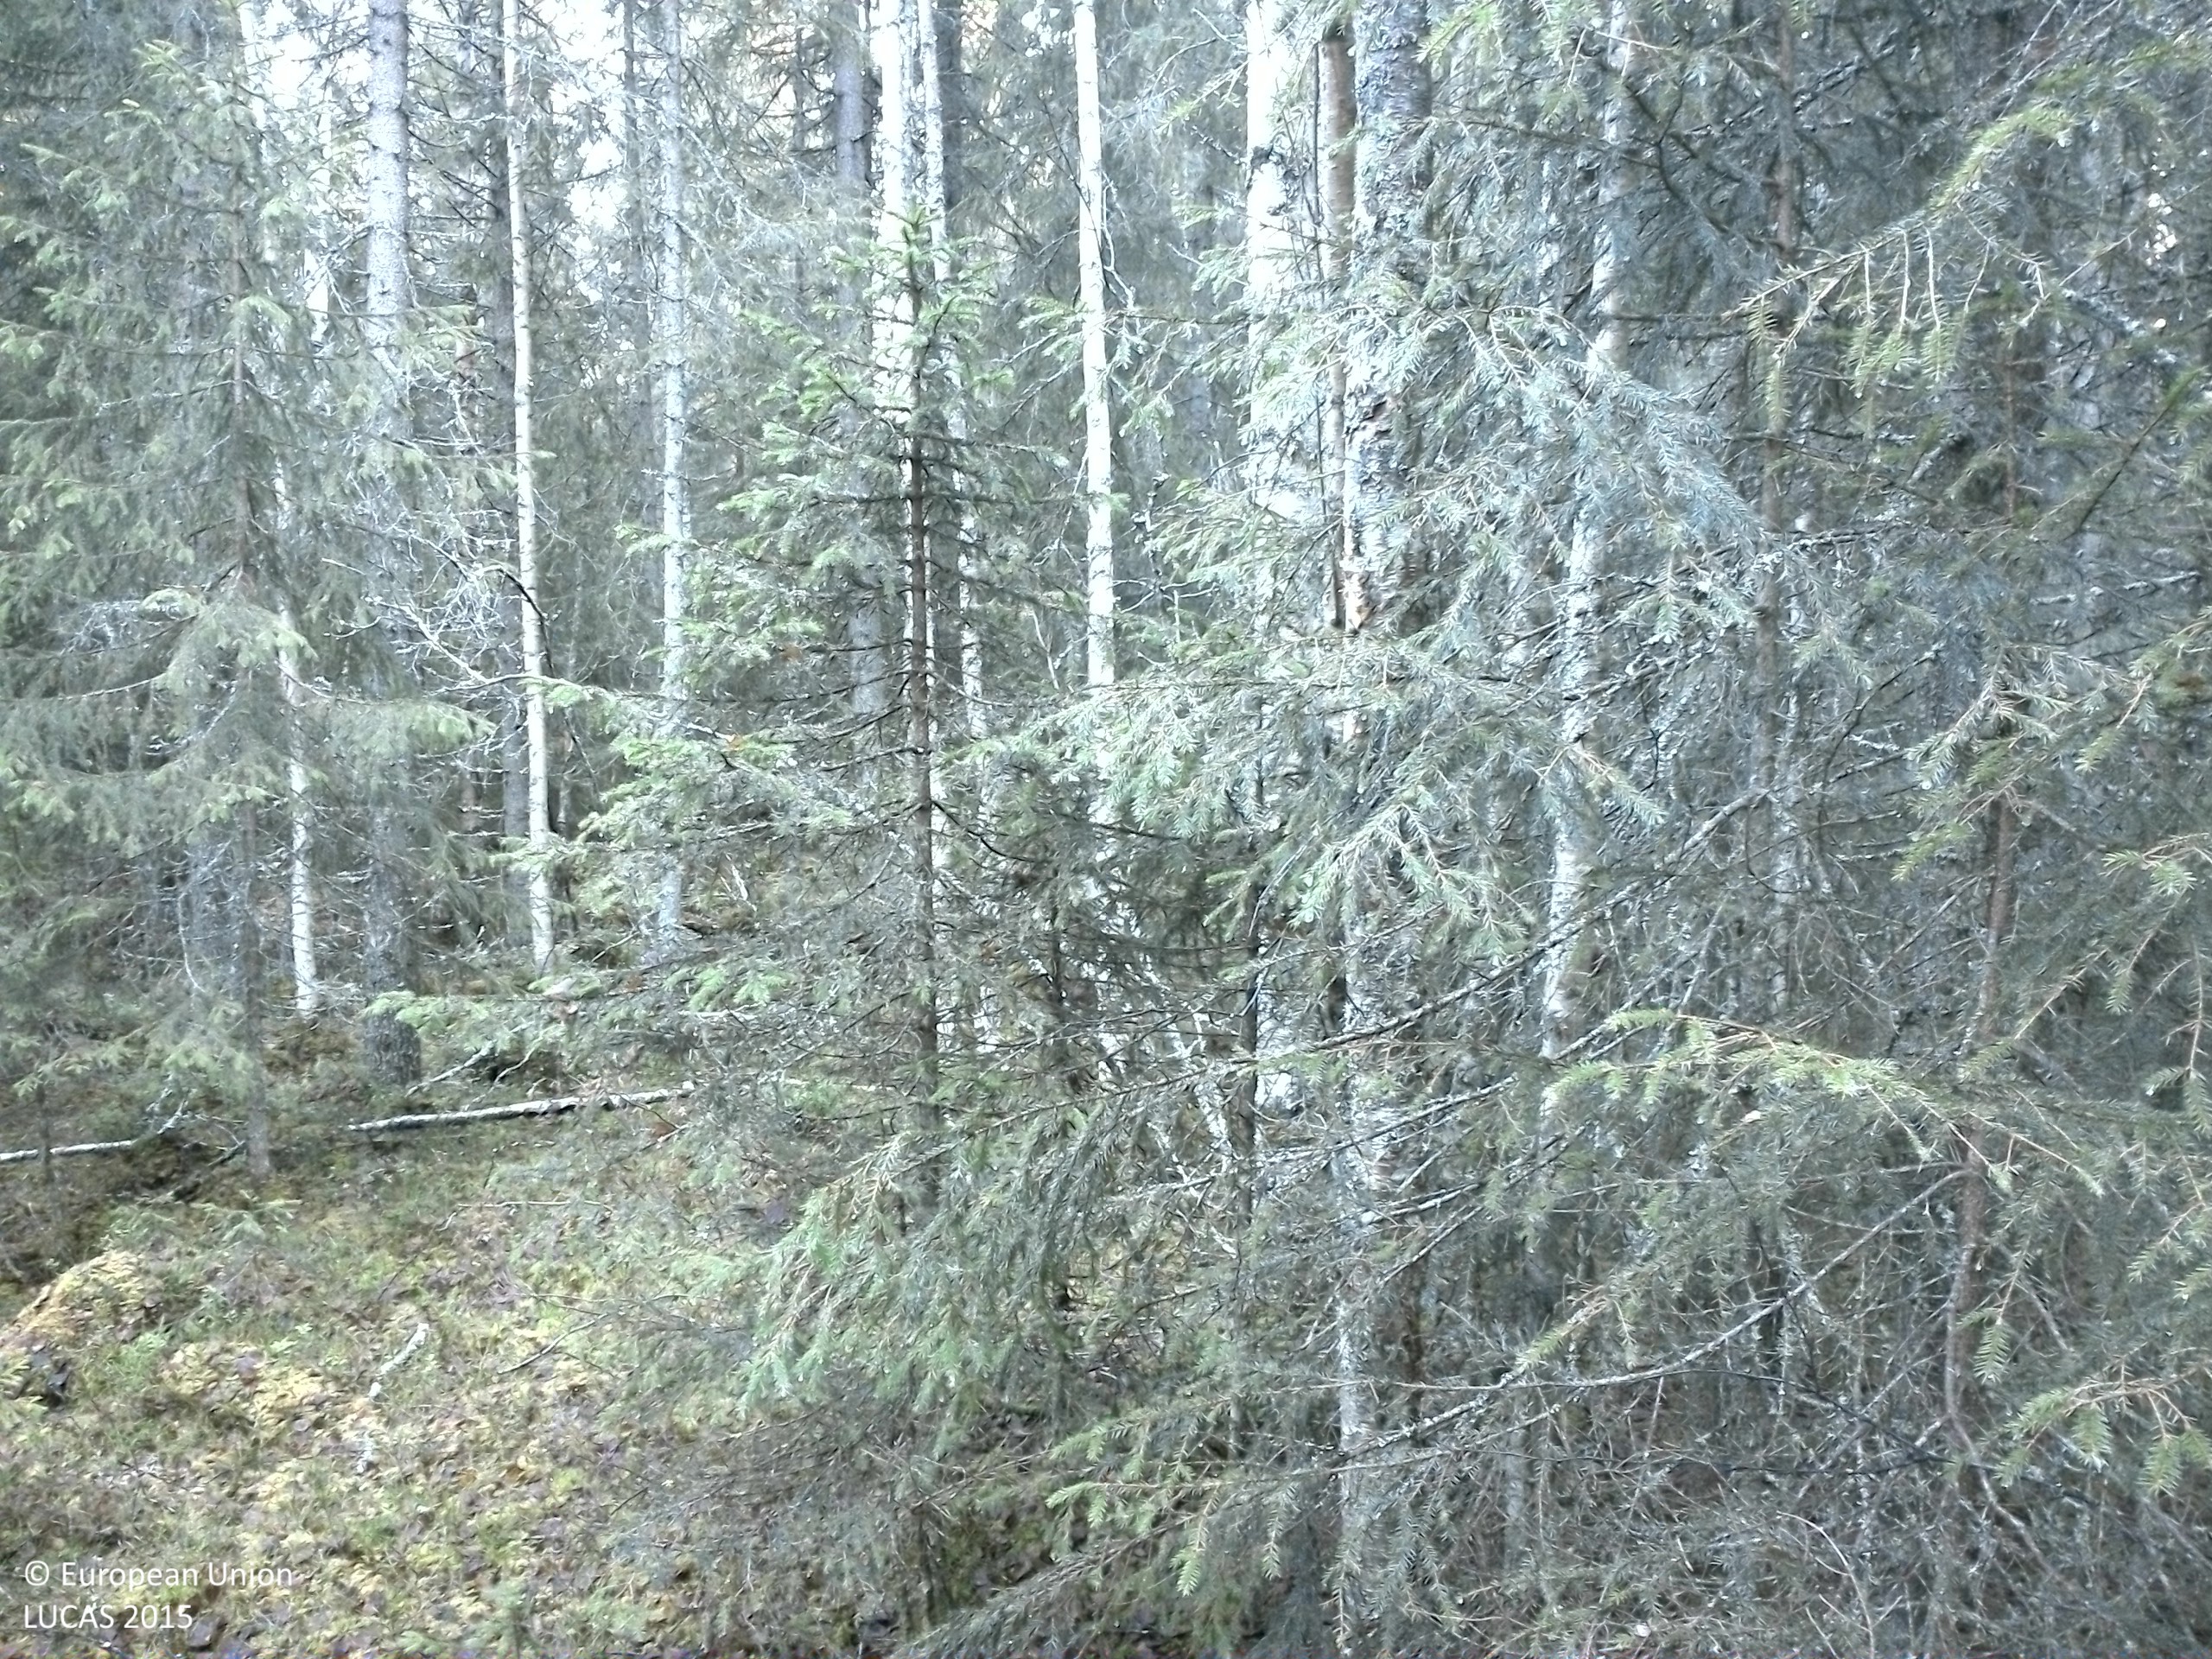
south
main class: Woodland
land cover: Spruce dominated mixed woodland
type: boreal forest
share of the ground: 50 - 75 %
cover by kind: coniferous forest trees 45 %, lichens and mosses 25 %, broadleaved forest trees 15 %, shrubs 15 %
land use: Forestry
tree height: > 5 m
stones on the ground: 25 - 50 %
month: October
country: SE
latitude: 63.8675
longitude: 16.0161
